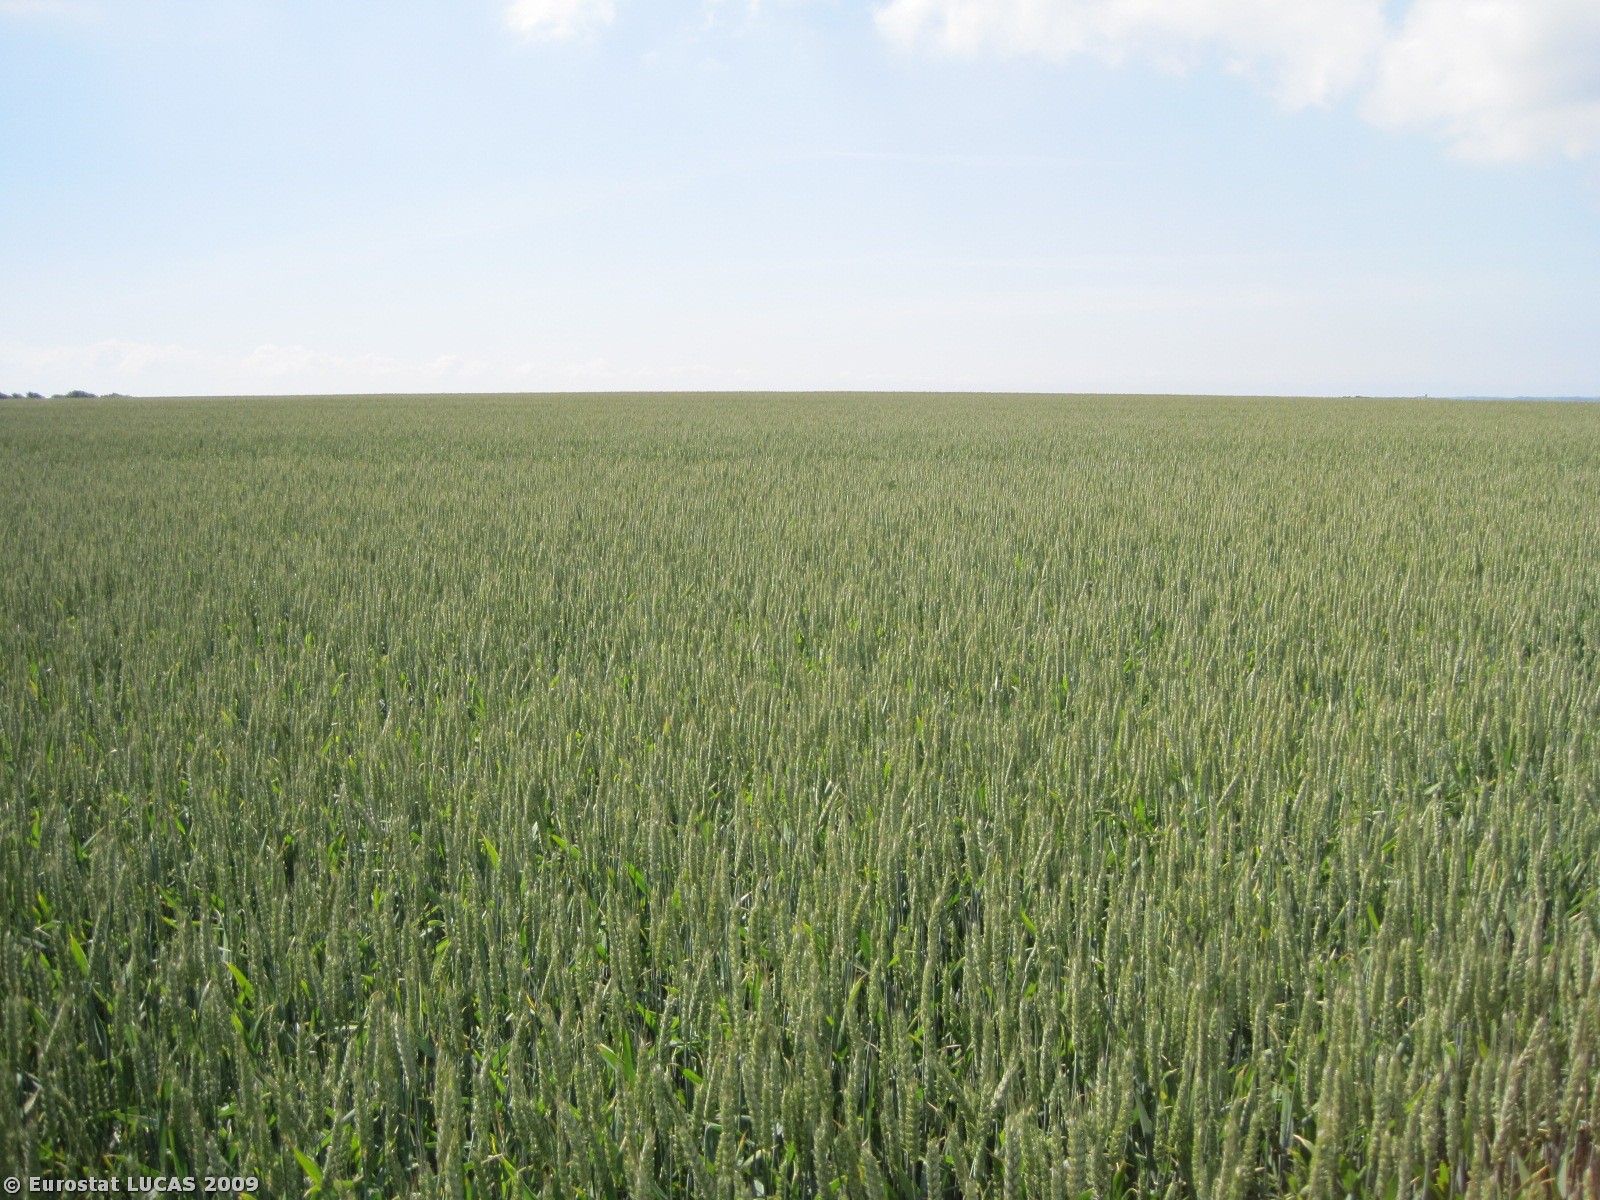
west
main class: Cropland
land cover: Common wheat
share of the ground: > 75 %
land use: Agriculture (excluding fallow land and kitchen gardens)
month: June
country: DK
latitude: 56.5427
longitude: 8.9117
